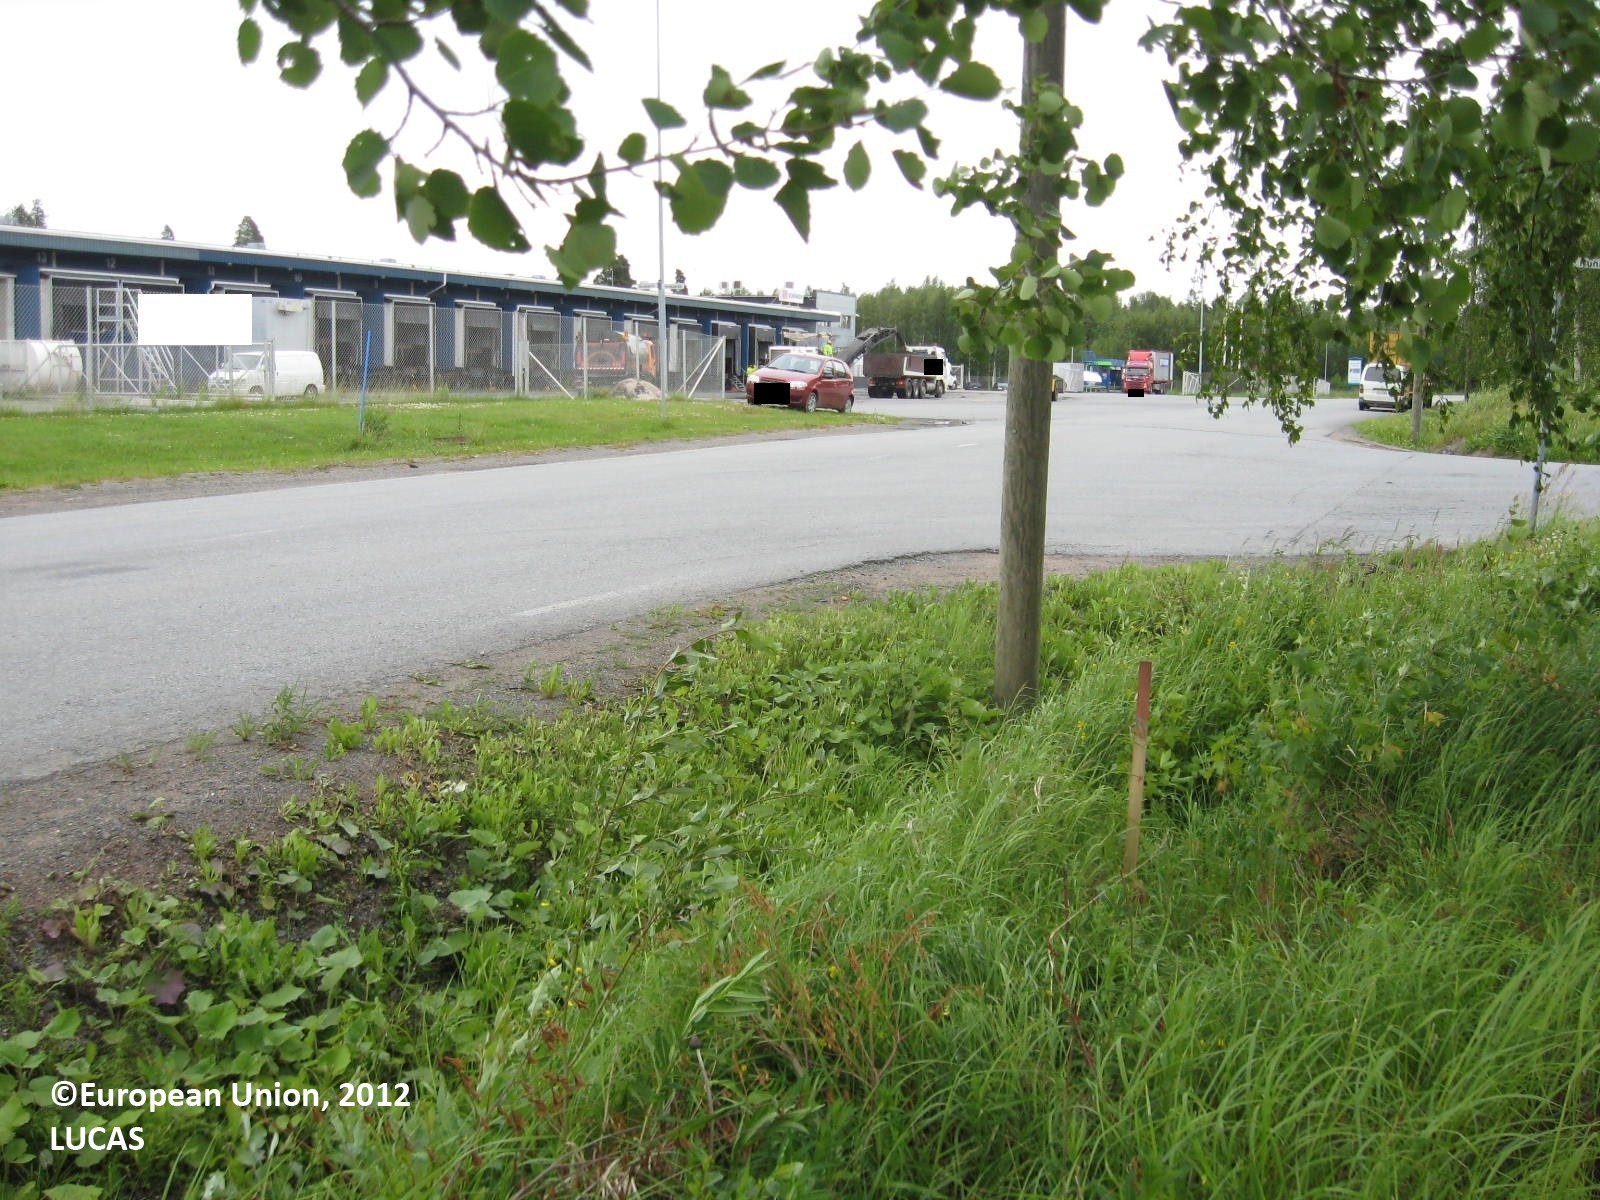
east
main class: Woodland
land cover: Broadleaved woodland
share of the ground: > 75 %
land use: Commerce, finance, business
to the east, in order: Broadleaved woodland; Artificial constructions in urban areas; Broadleaved woodland; Electric lines; Broadleaved woodland
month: June
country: FI
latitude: 62.7875
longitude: 22.8980
